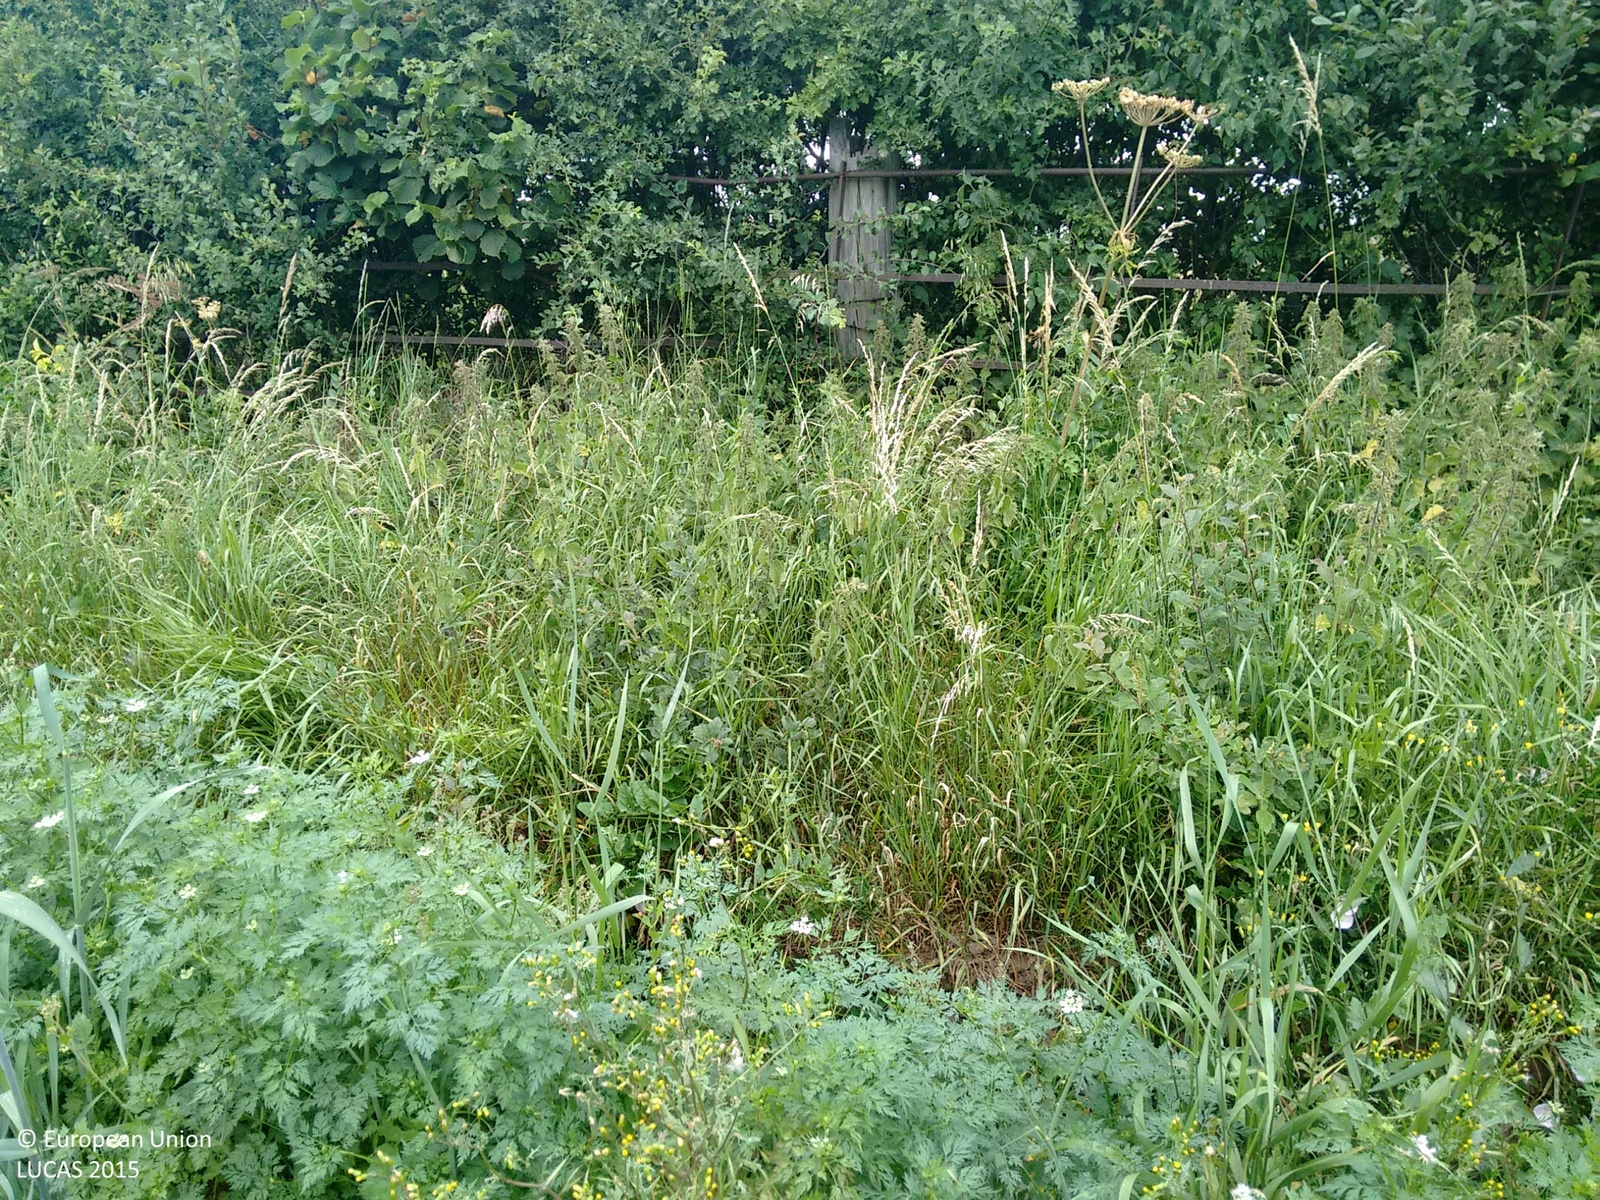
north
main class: Cropland
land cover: Potatoes
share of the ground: > 75 %
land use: Agriculture (excluding fallow land and kitchen gardens)
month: July
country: GB
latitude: 52.2334
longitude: -2.2297
